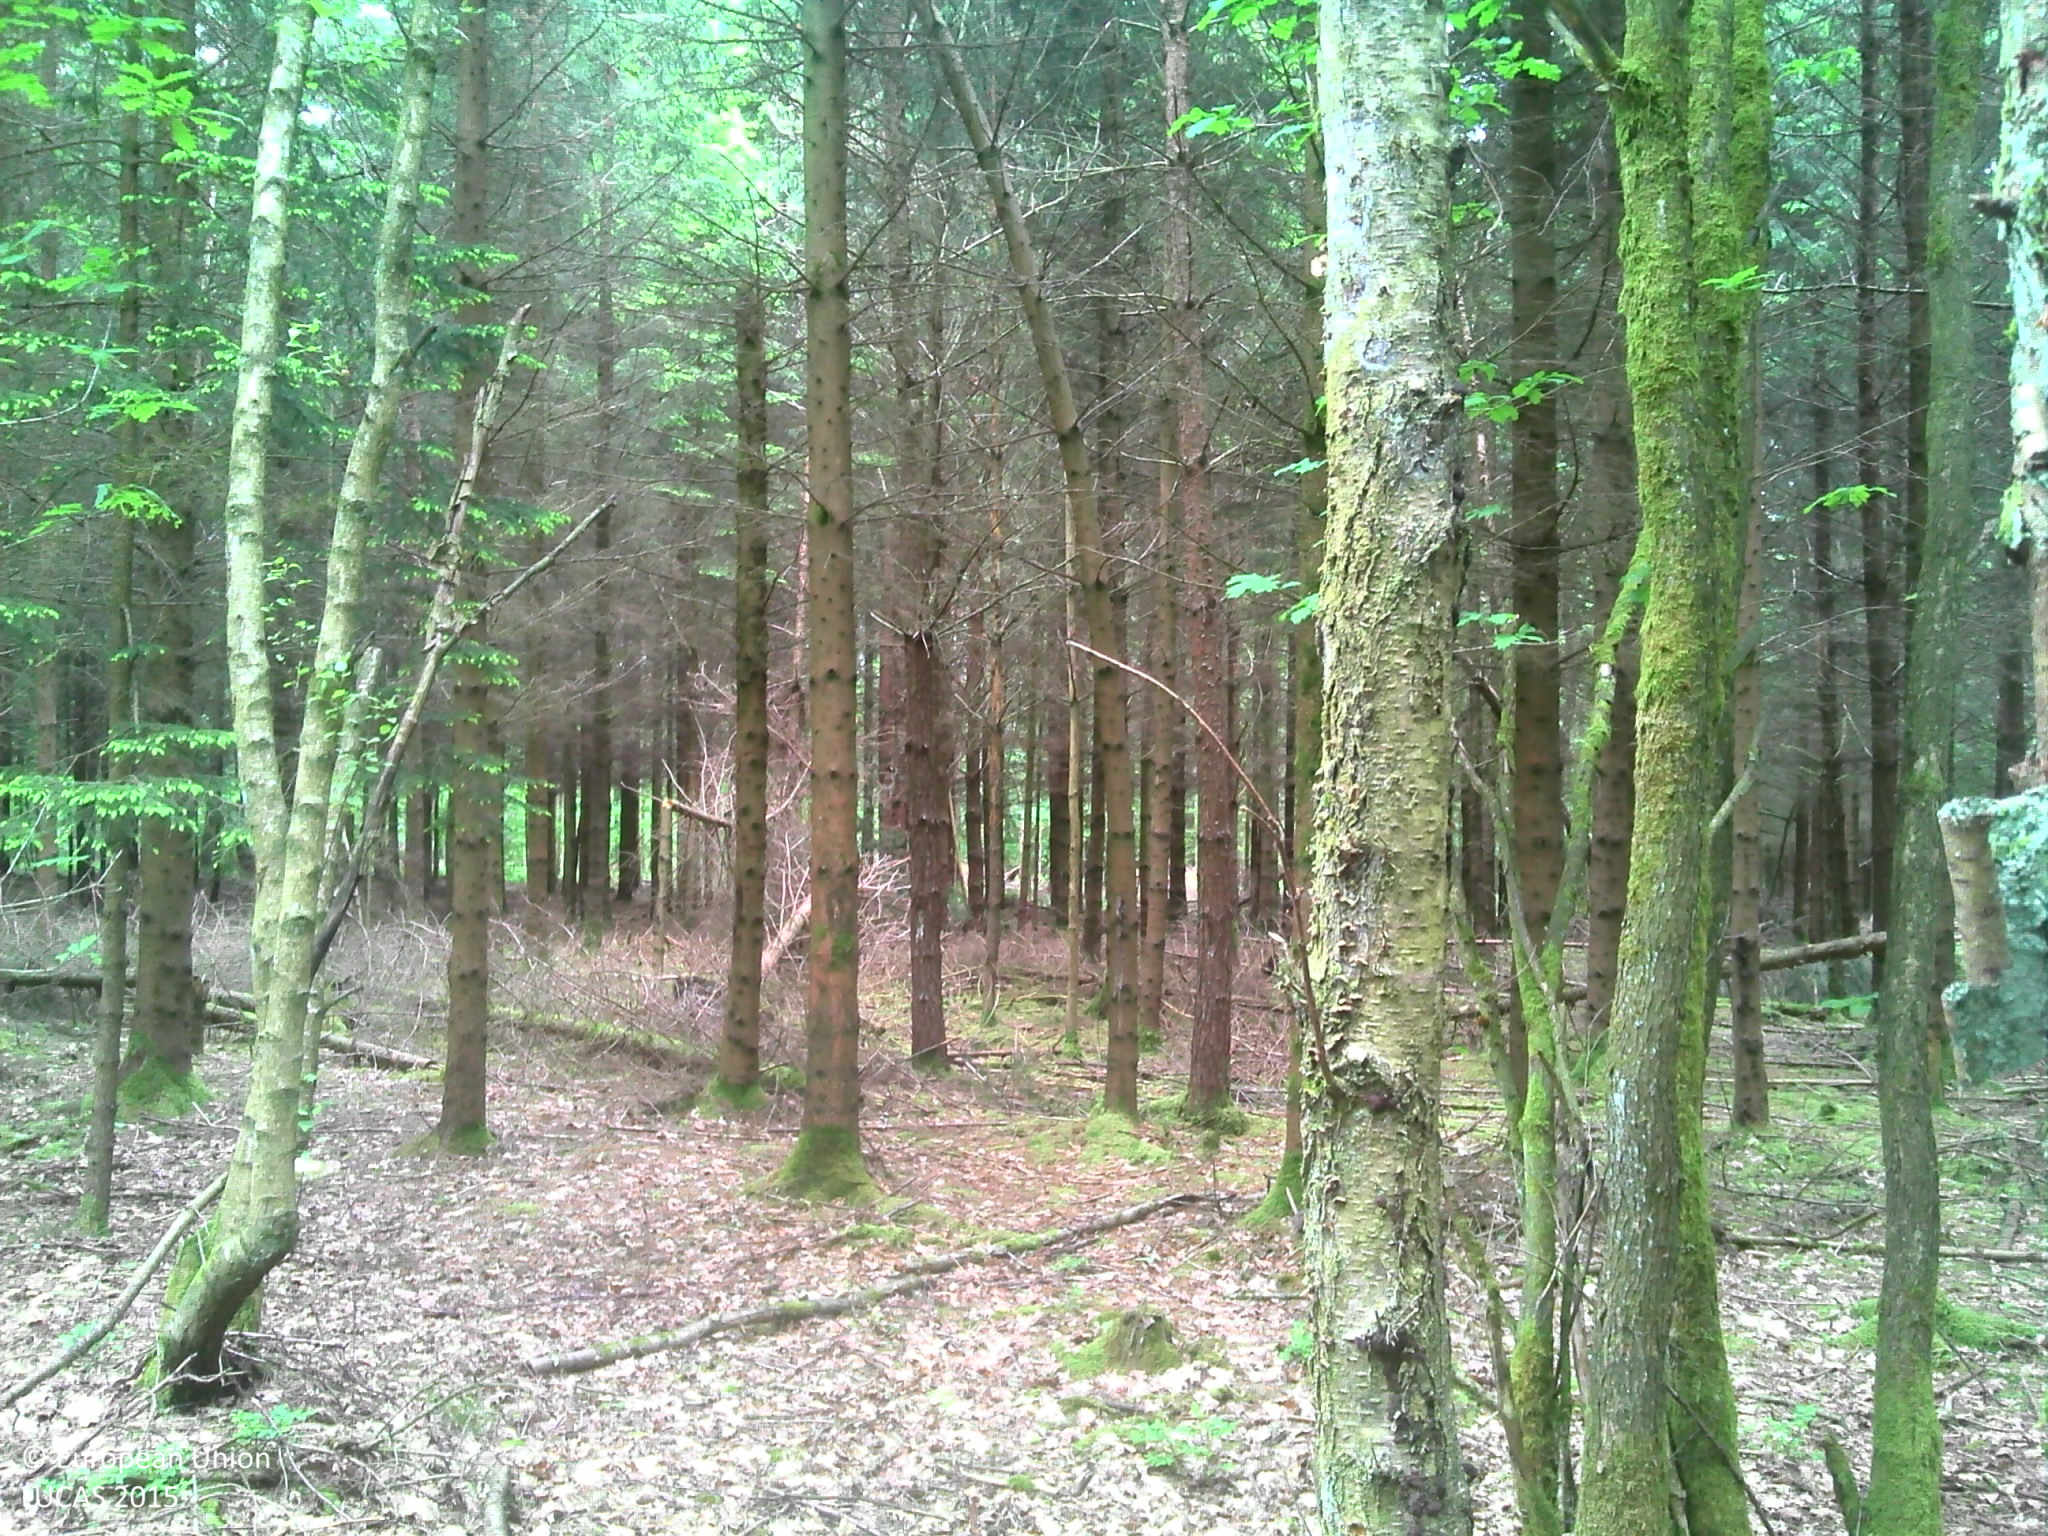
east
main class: Woodland
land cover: Pine dominated mixed woodland
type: hemiboreal forest and nemoral coniferous forest and mixed broadleaved-coniferous forest
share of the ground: > 75 %
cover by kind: broadleaved forest trees 50 %, coniferous forest trees 40 %, herbaceous plants 10 %
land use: Forestry
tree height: > 5 m
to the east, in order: Pine dominated mixed woodland; Spruce dominated coniferous woodland; Pine dominated mixed woodland; Tracks; Spruce dominated coniferous woodland
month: June
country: BE
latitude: 50.0534
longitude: 4.9272
